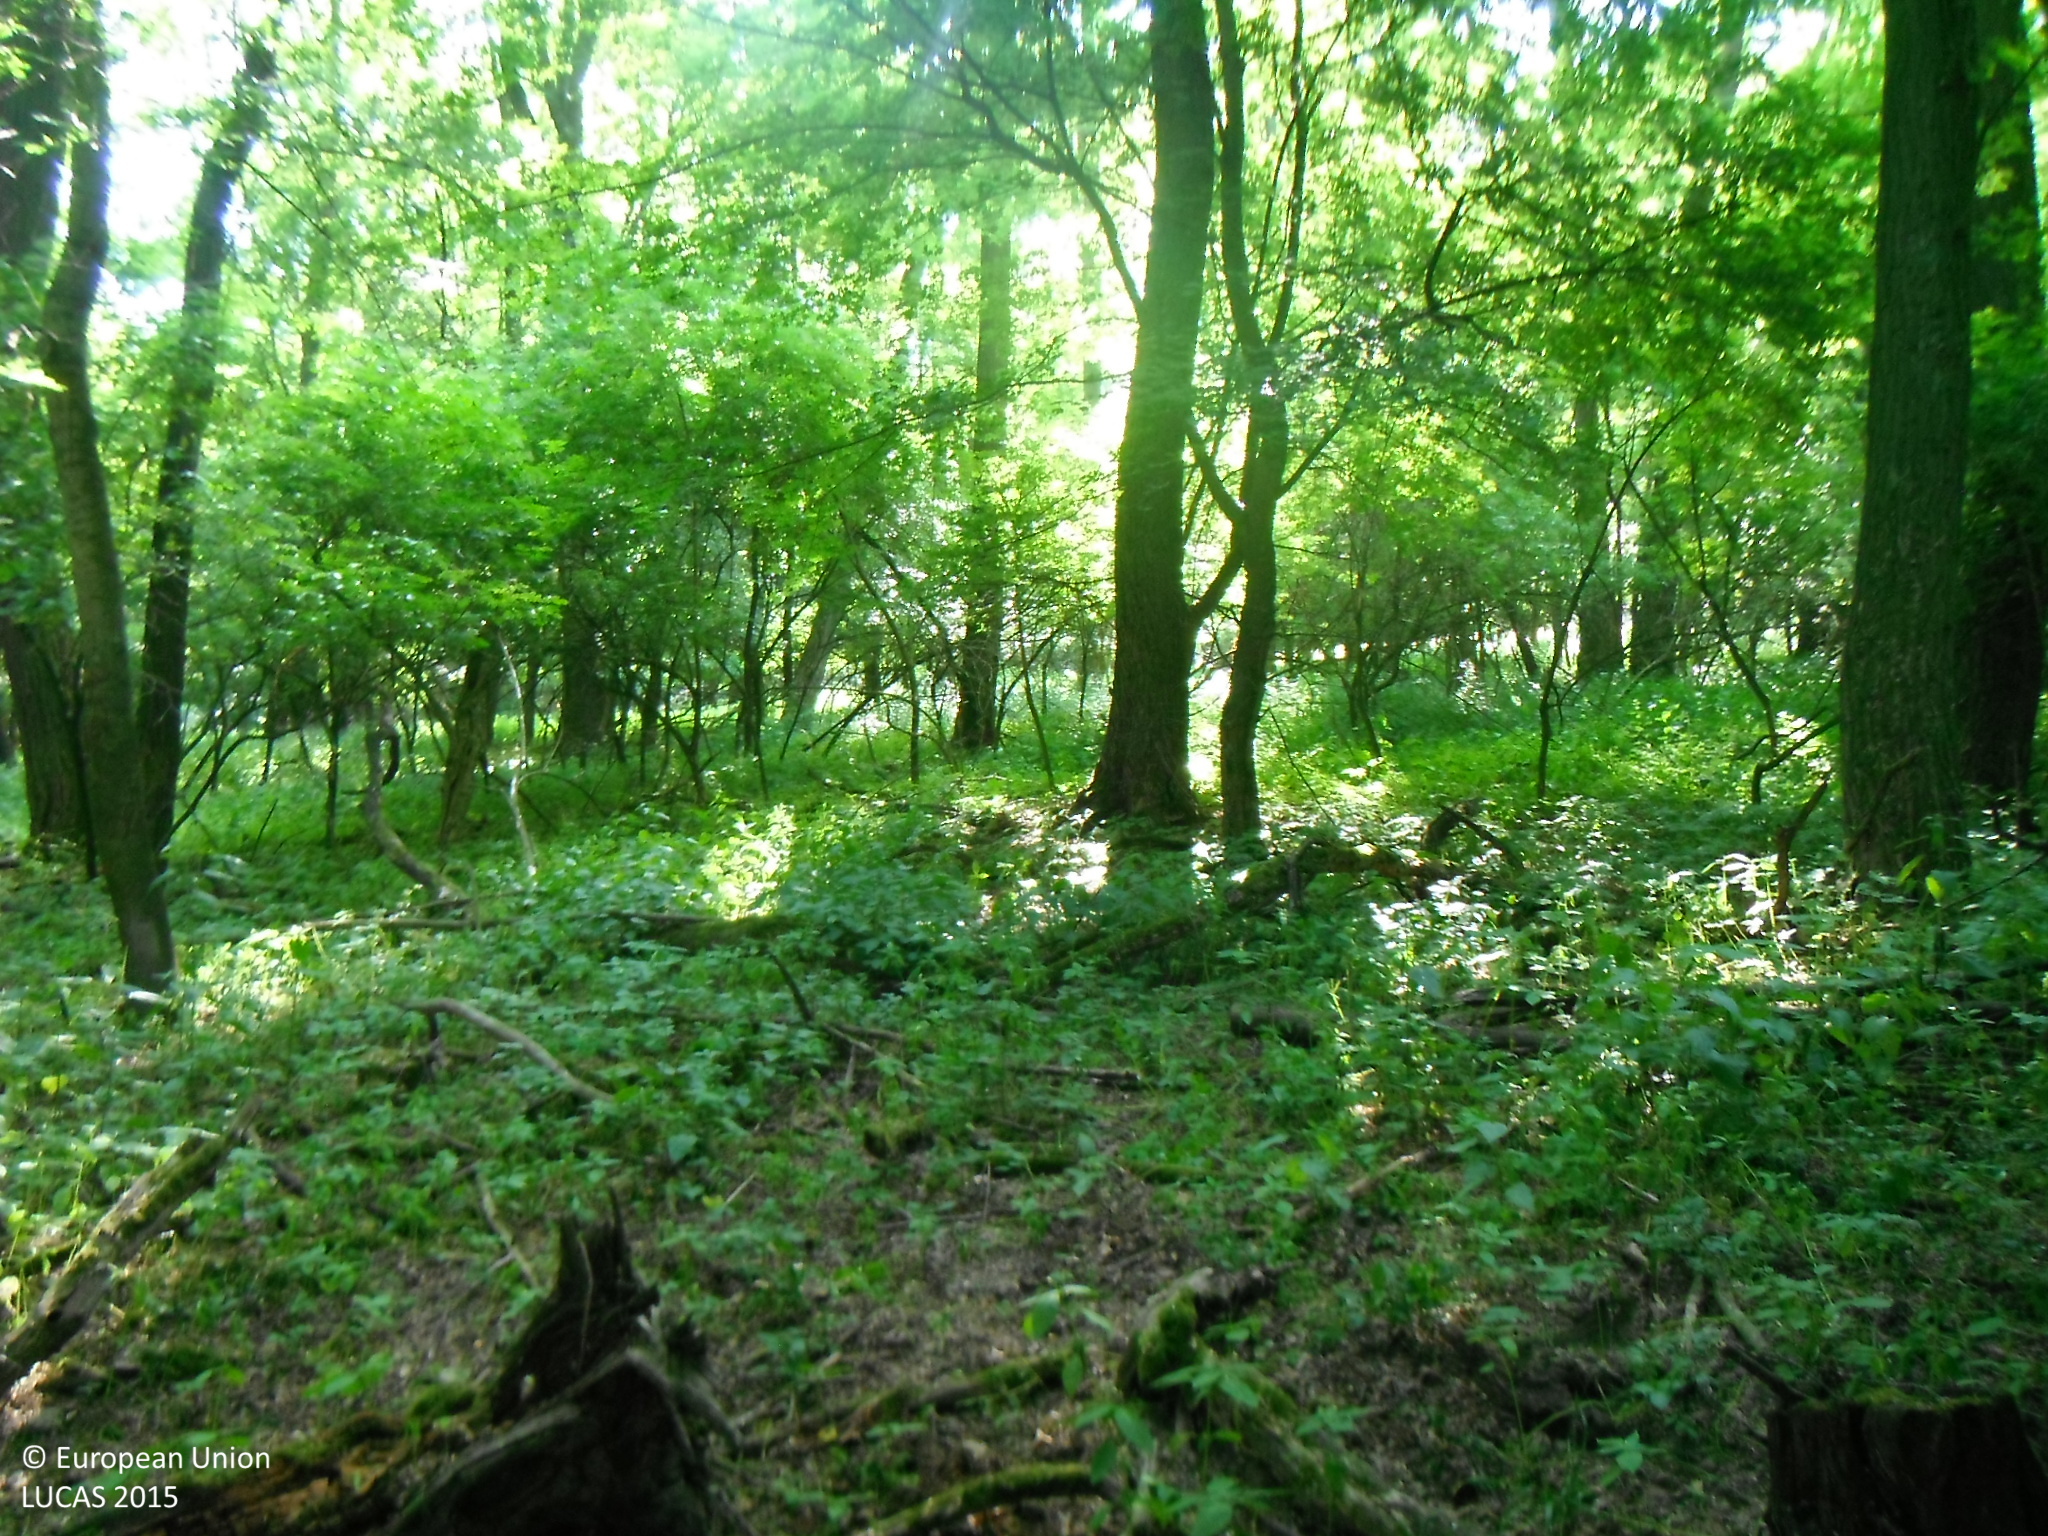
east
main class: Woodland
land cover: Broadleaved woodland
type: mesophytic deciduous forest
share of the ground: > 75 %
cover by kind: broadleaved forest trees 95 %, herbaceous plants 5 %
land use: Forestry
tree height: > 5 m
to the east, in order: Broadleaved woodland; Spontaneously vegetated surfaces; Broadleaved woodland
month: June
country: SK
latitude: 48.5854
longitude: 17.4531
